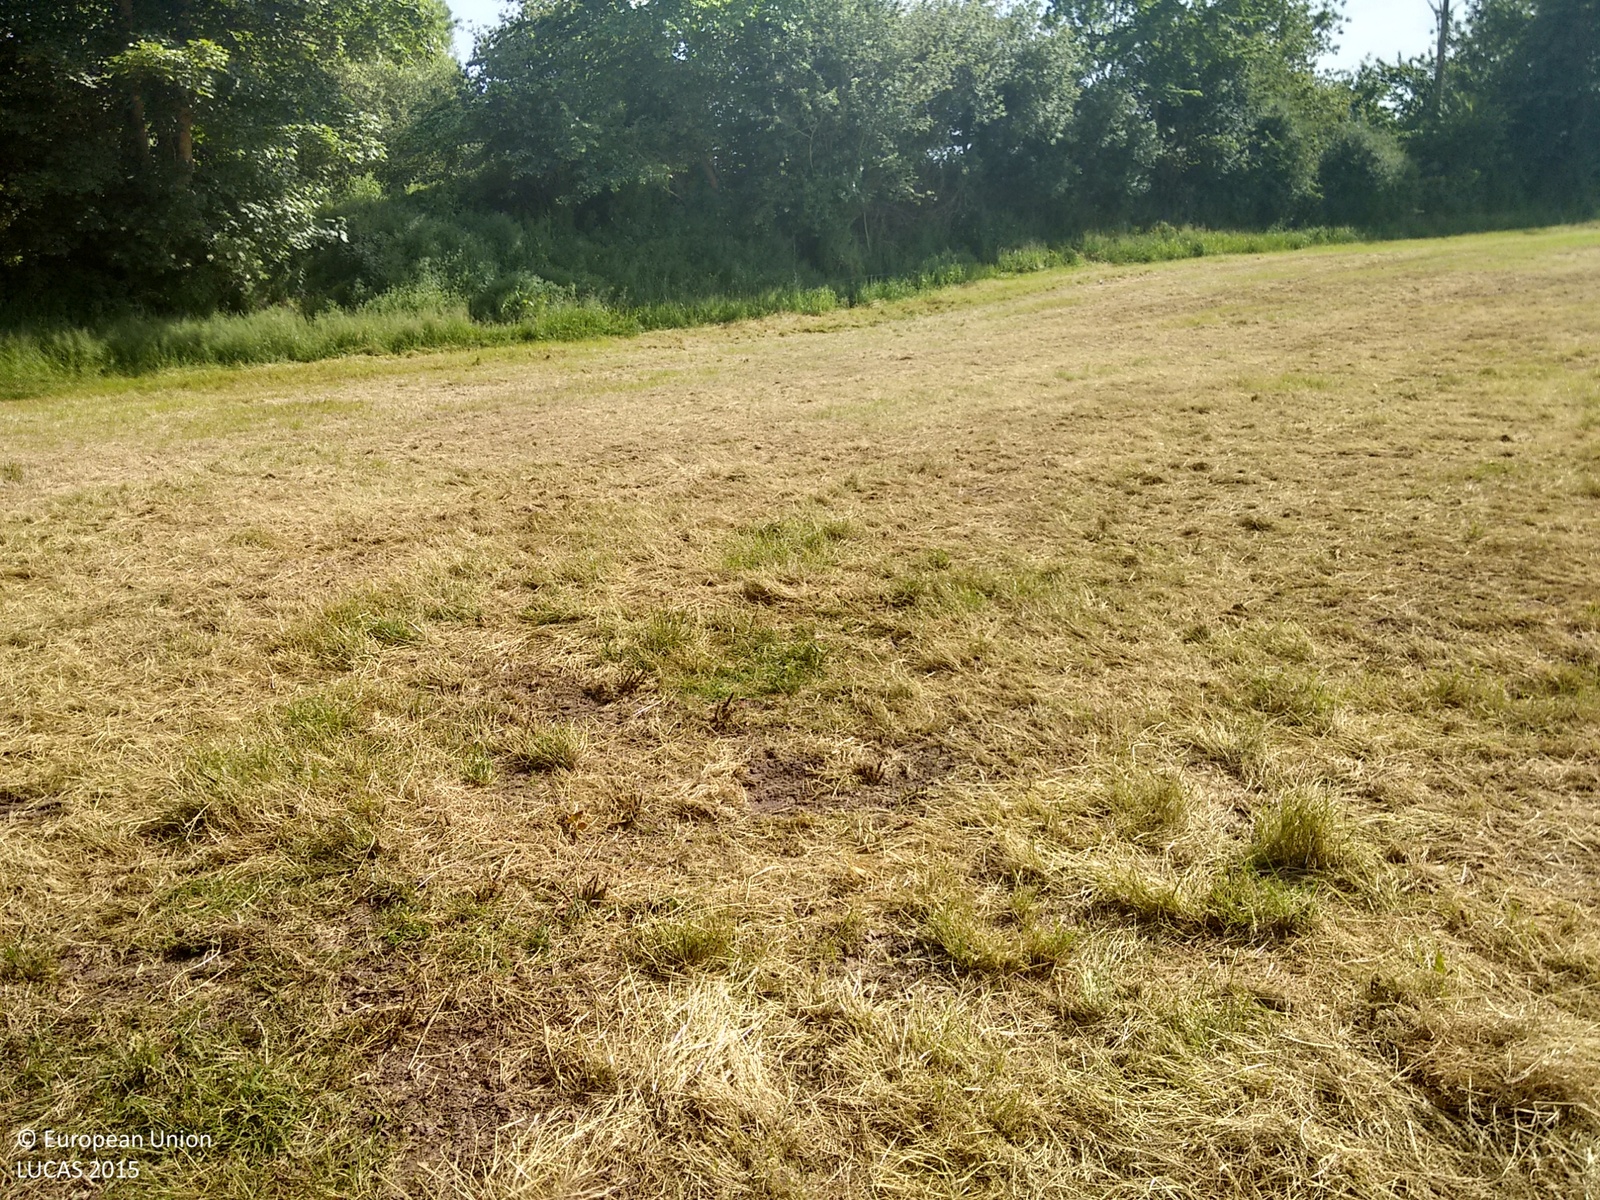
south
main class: Grassland
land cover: Grassland without tree/shrub cover
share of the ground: > 75 %
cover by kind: herbaceous plants 100 %
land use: Agriculture (excluding fallow land and kitchen gardens)
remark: Harvested field
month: June
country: IE
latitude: 51.9443
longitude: -7.9970
